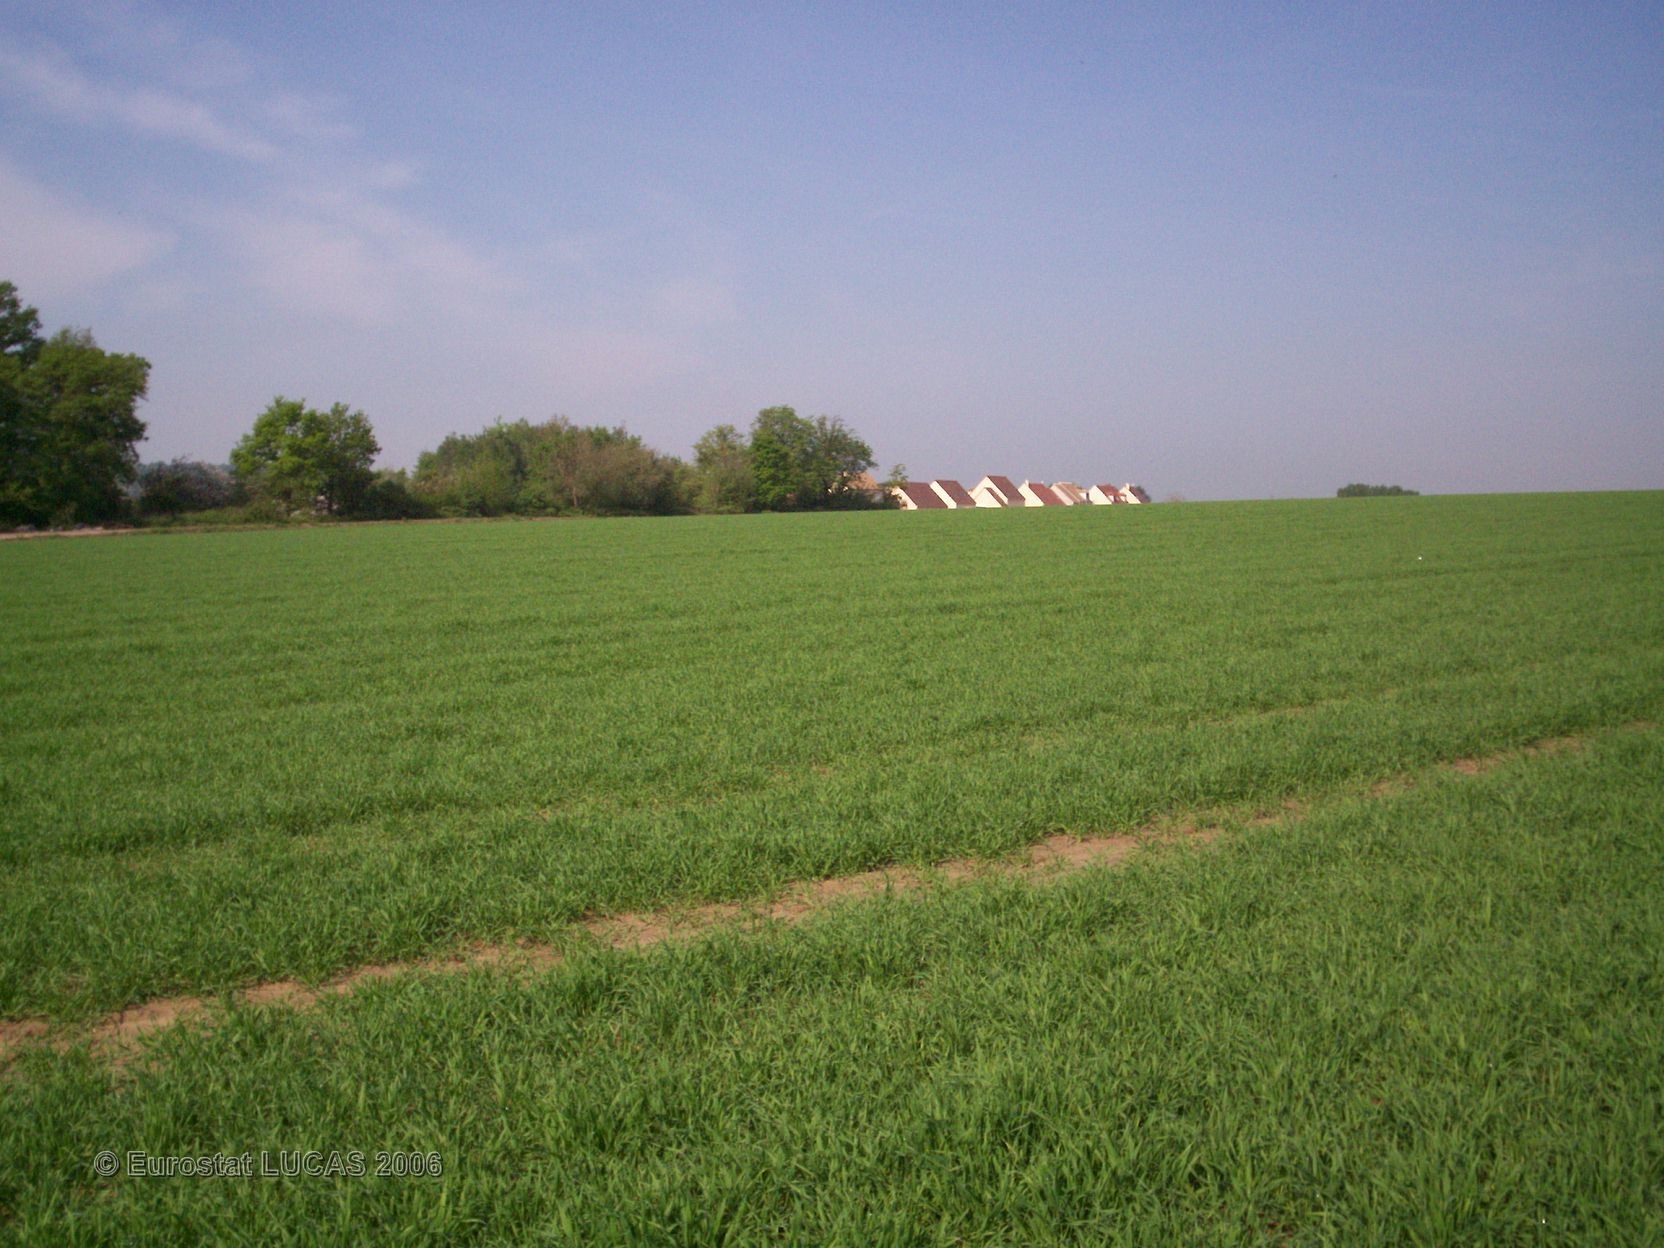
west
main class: Cropland
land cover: Barley
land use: Agriculture (excluding fallow land and kitchen gardens)
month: May
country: FR
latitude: 49.0523
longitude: 2.7789
